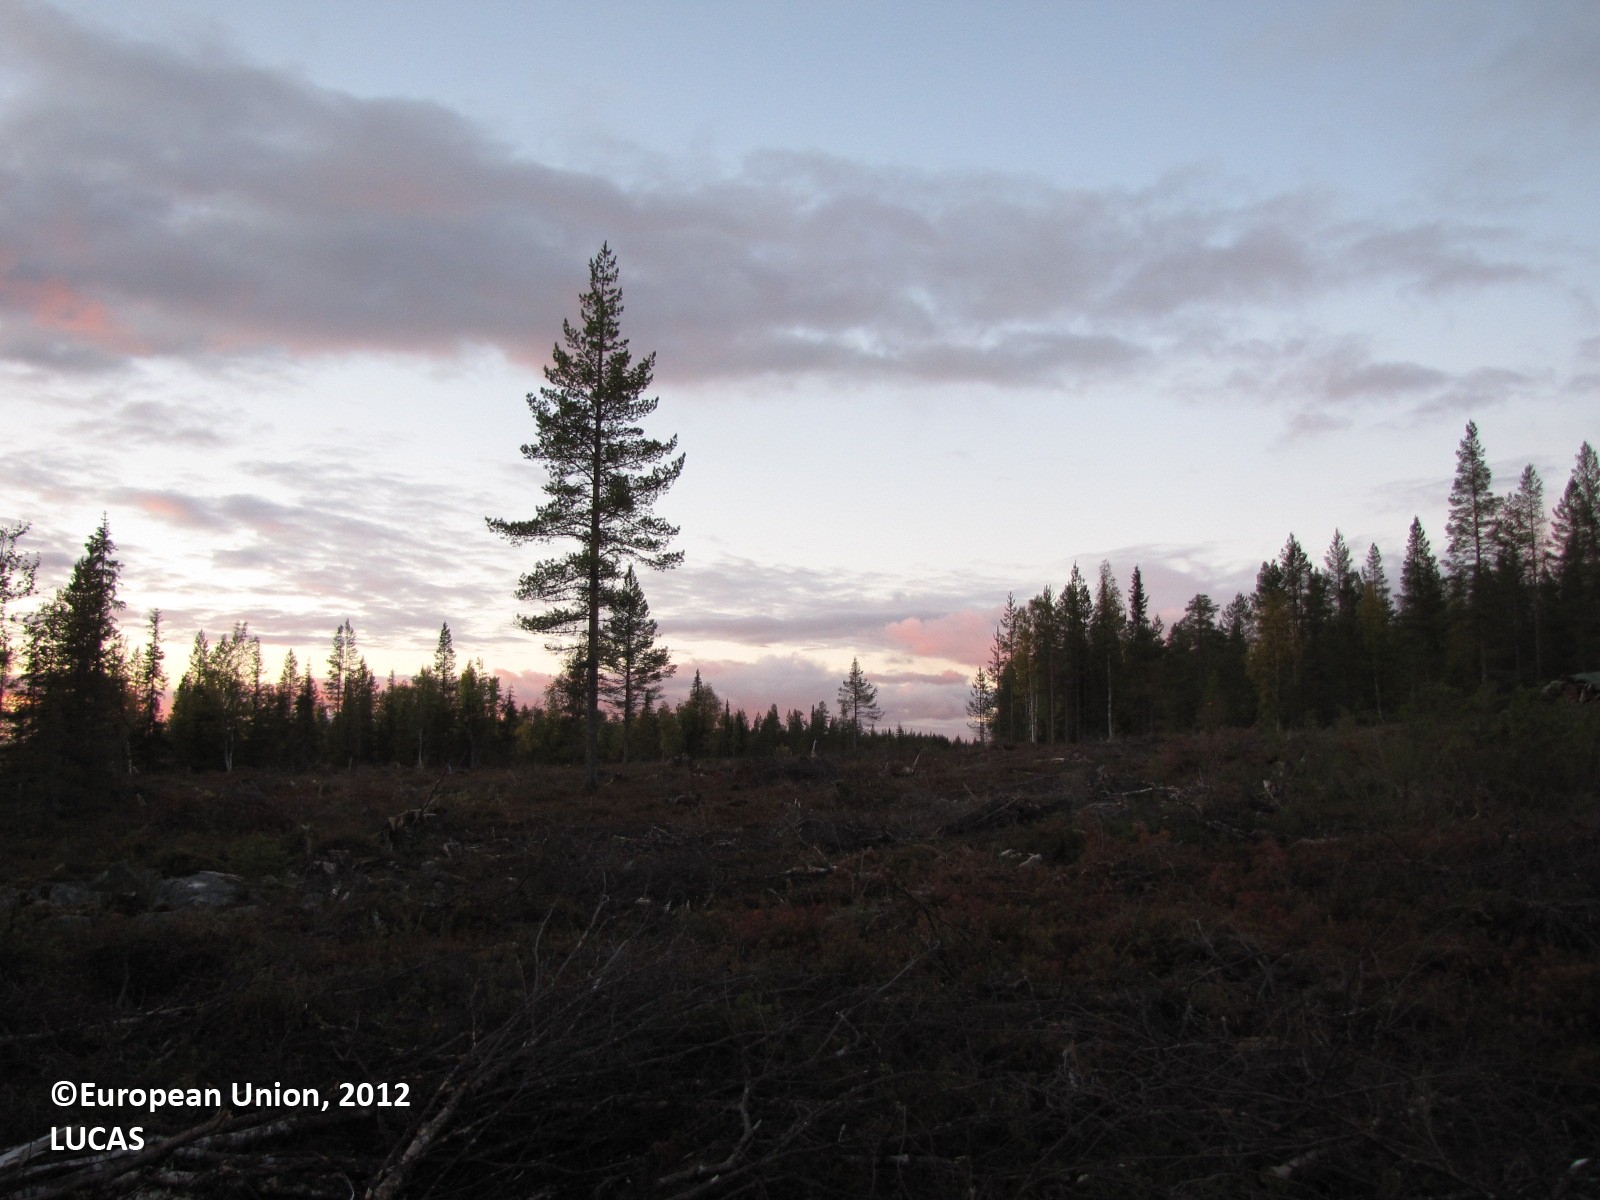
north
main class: Shrubland
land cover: Shrubland without tree cover
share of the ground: 10 - 25 %
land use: Forestry
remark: Clear cut
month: September
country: FI
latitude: 67.3745
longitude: 25.2567
